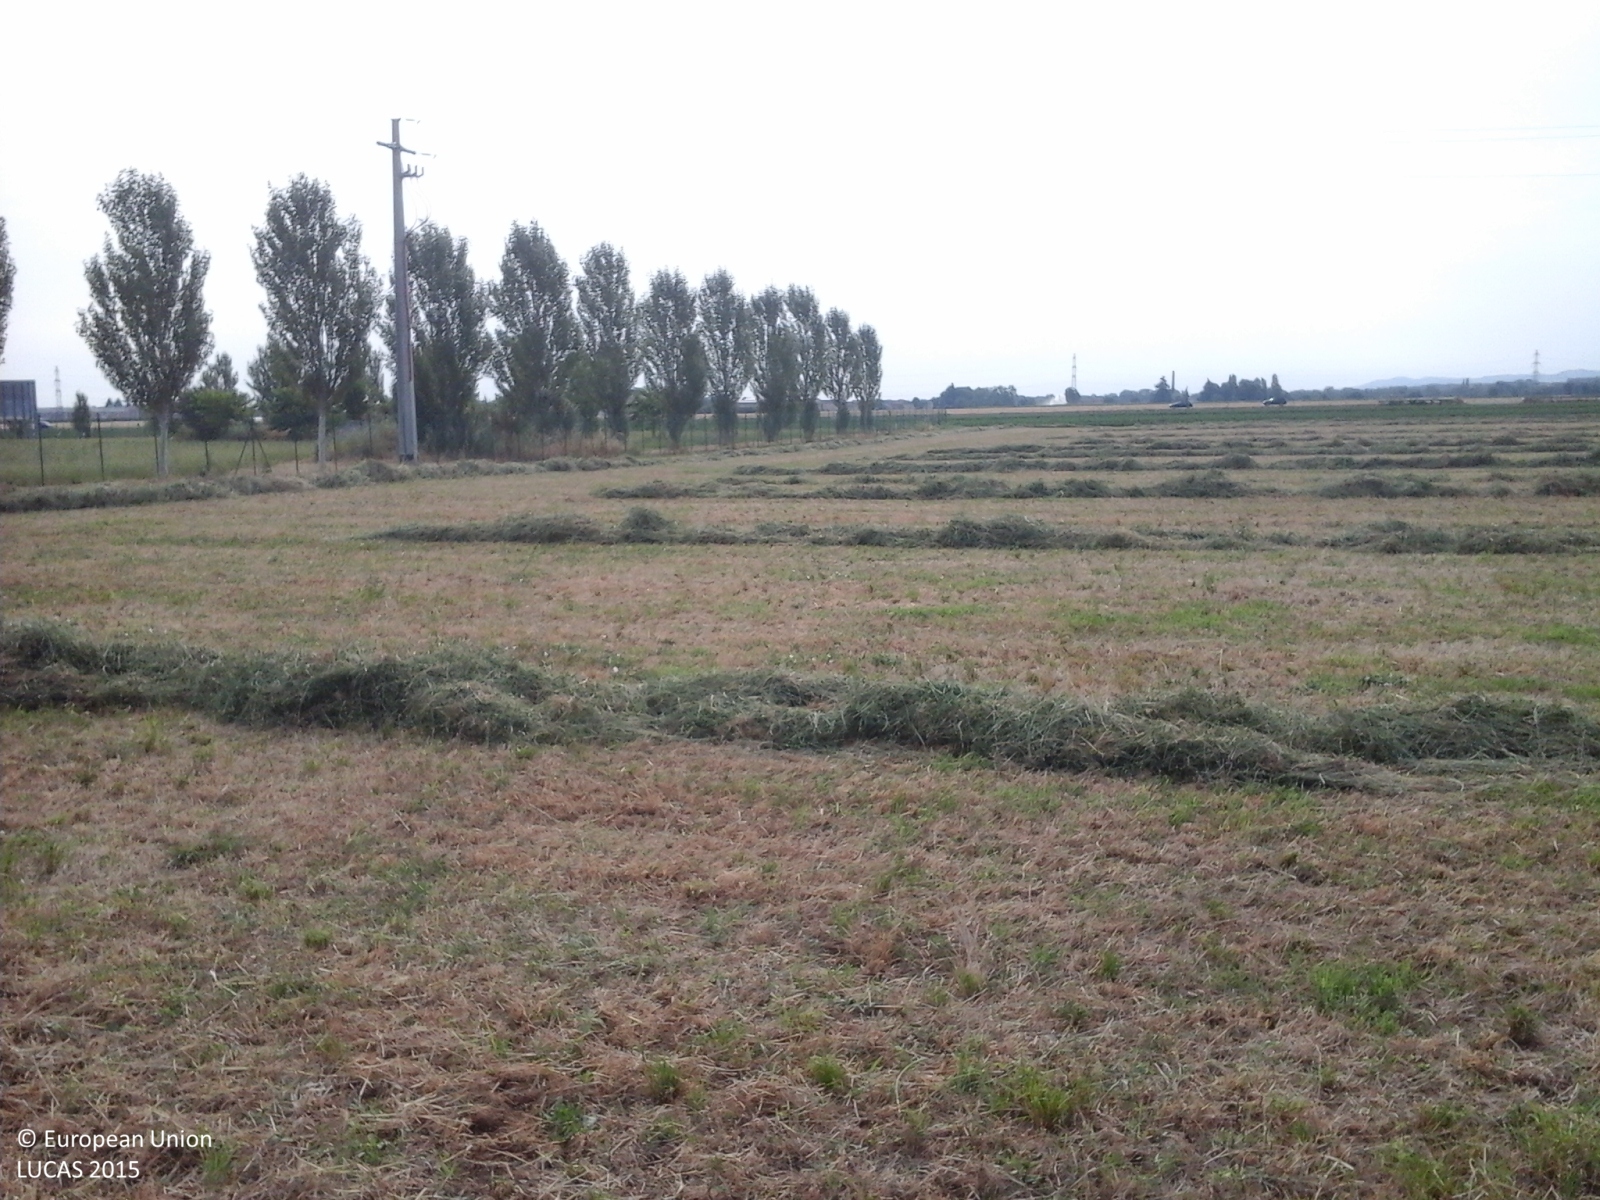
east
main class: Cropland
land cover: Lucerne
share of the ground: > 75 %
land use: Agriculture (excluding fallow land and kitchen gardens)
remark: Clear cut
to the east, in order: Lucerne; Electric lines; Lucerne; Artificial constructions in urban areas; Tomatoes; Tracks; Tomatoes
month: June
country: IT
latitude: 44.6748
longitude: 10.2895
